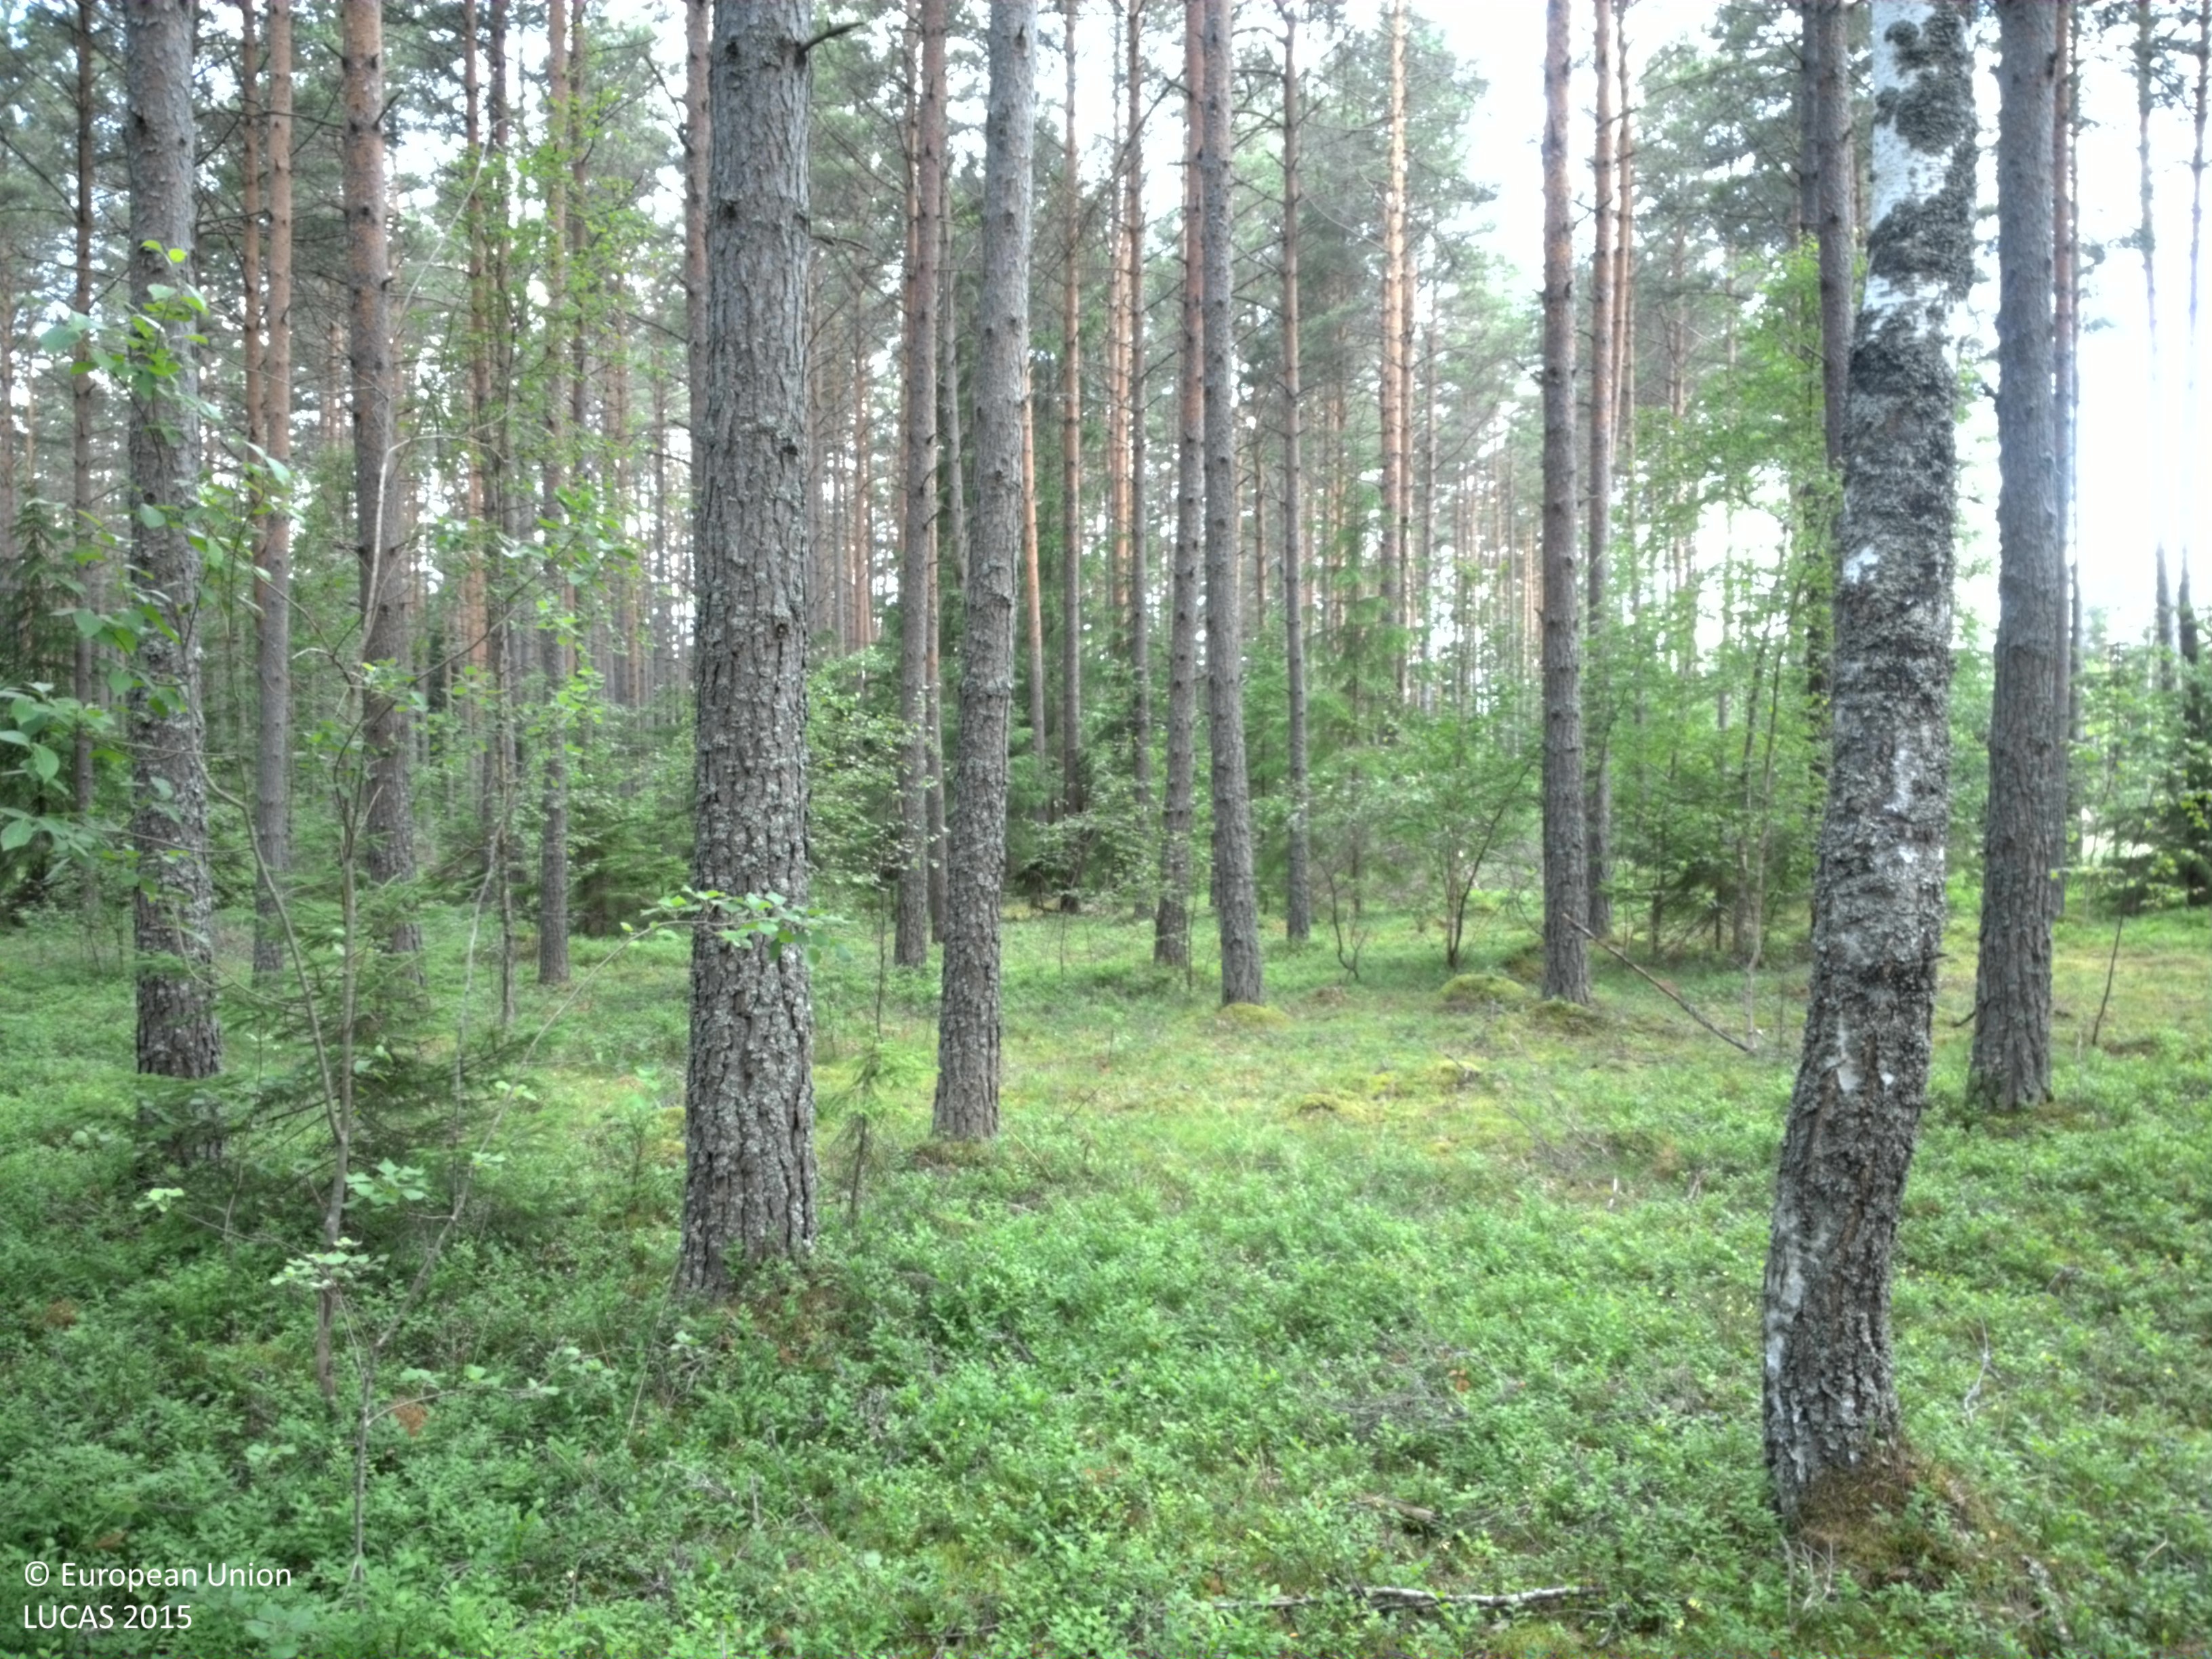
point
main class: Woodland
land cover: Pine dominated mixed woodland
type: boreal forest
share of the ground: > 75 %
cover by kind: coniferous forest trees 60 %, broadleaved forest trees 20 %, herbaceous plants 20 %
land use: Forestry
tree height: > 5 m
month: July
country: SE
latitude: 59.6165
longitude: 18.4900
